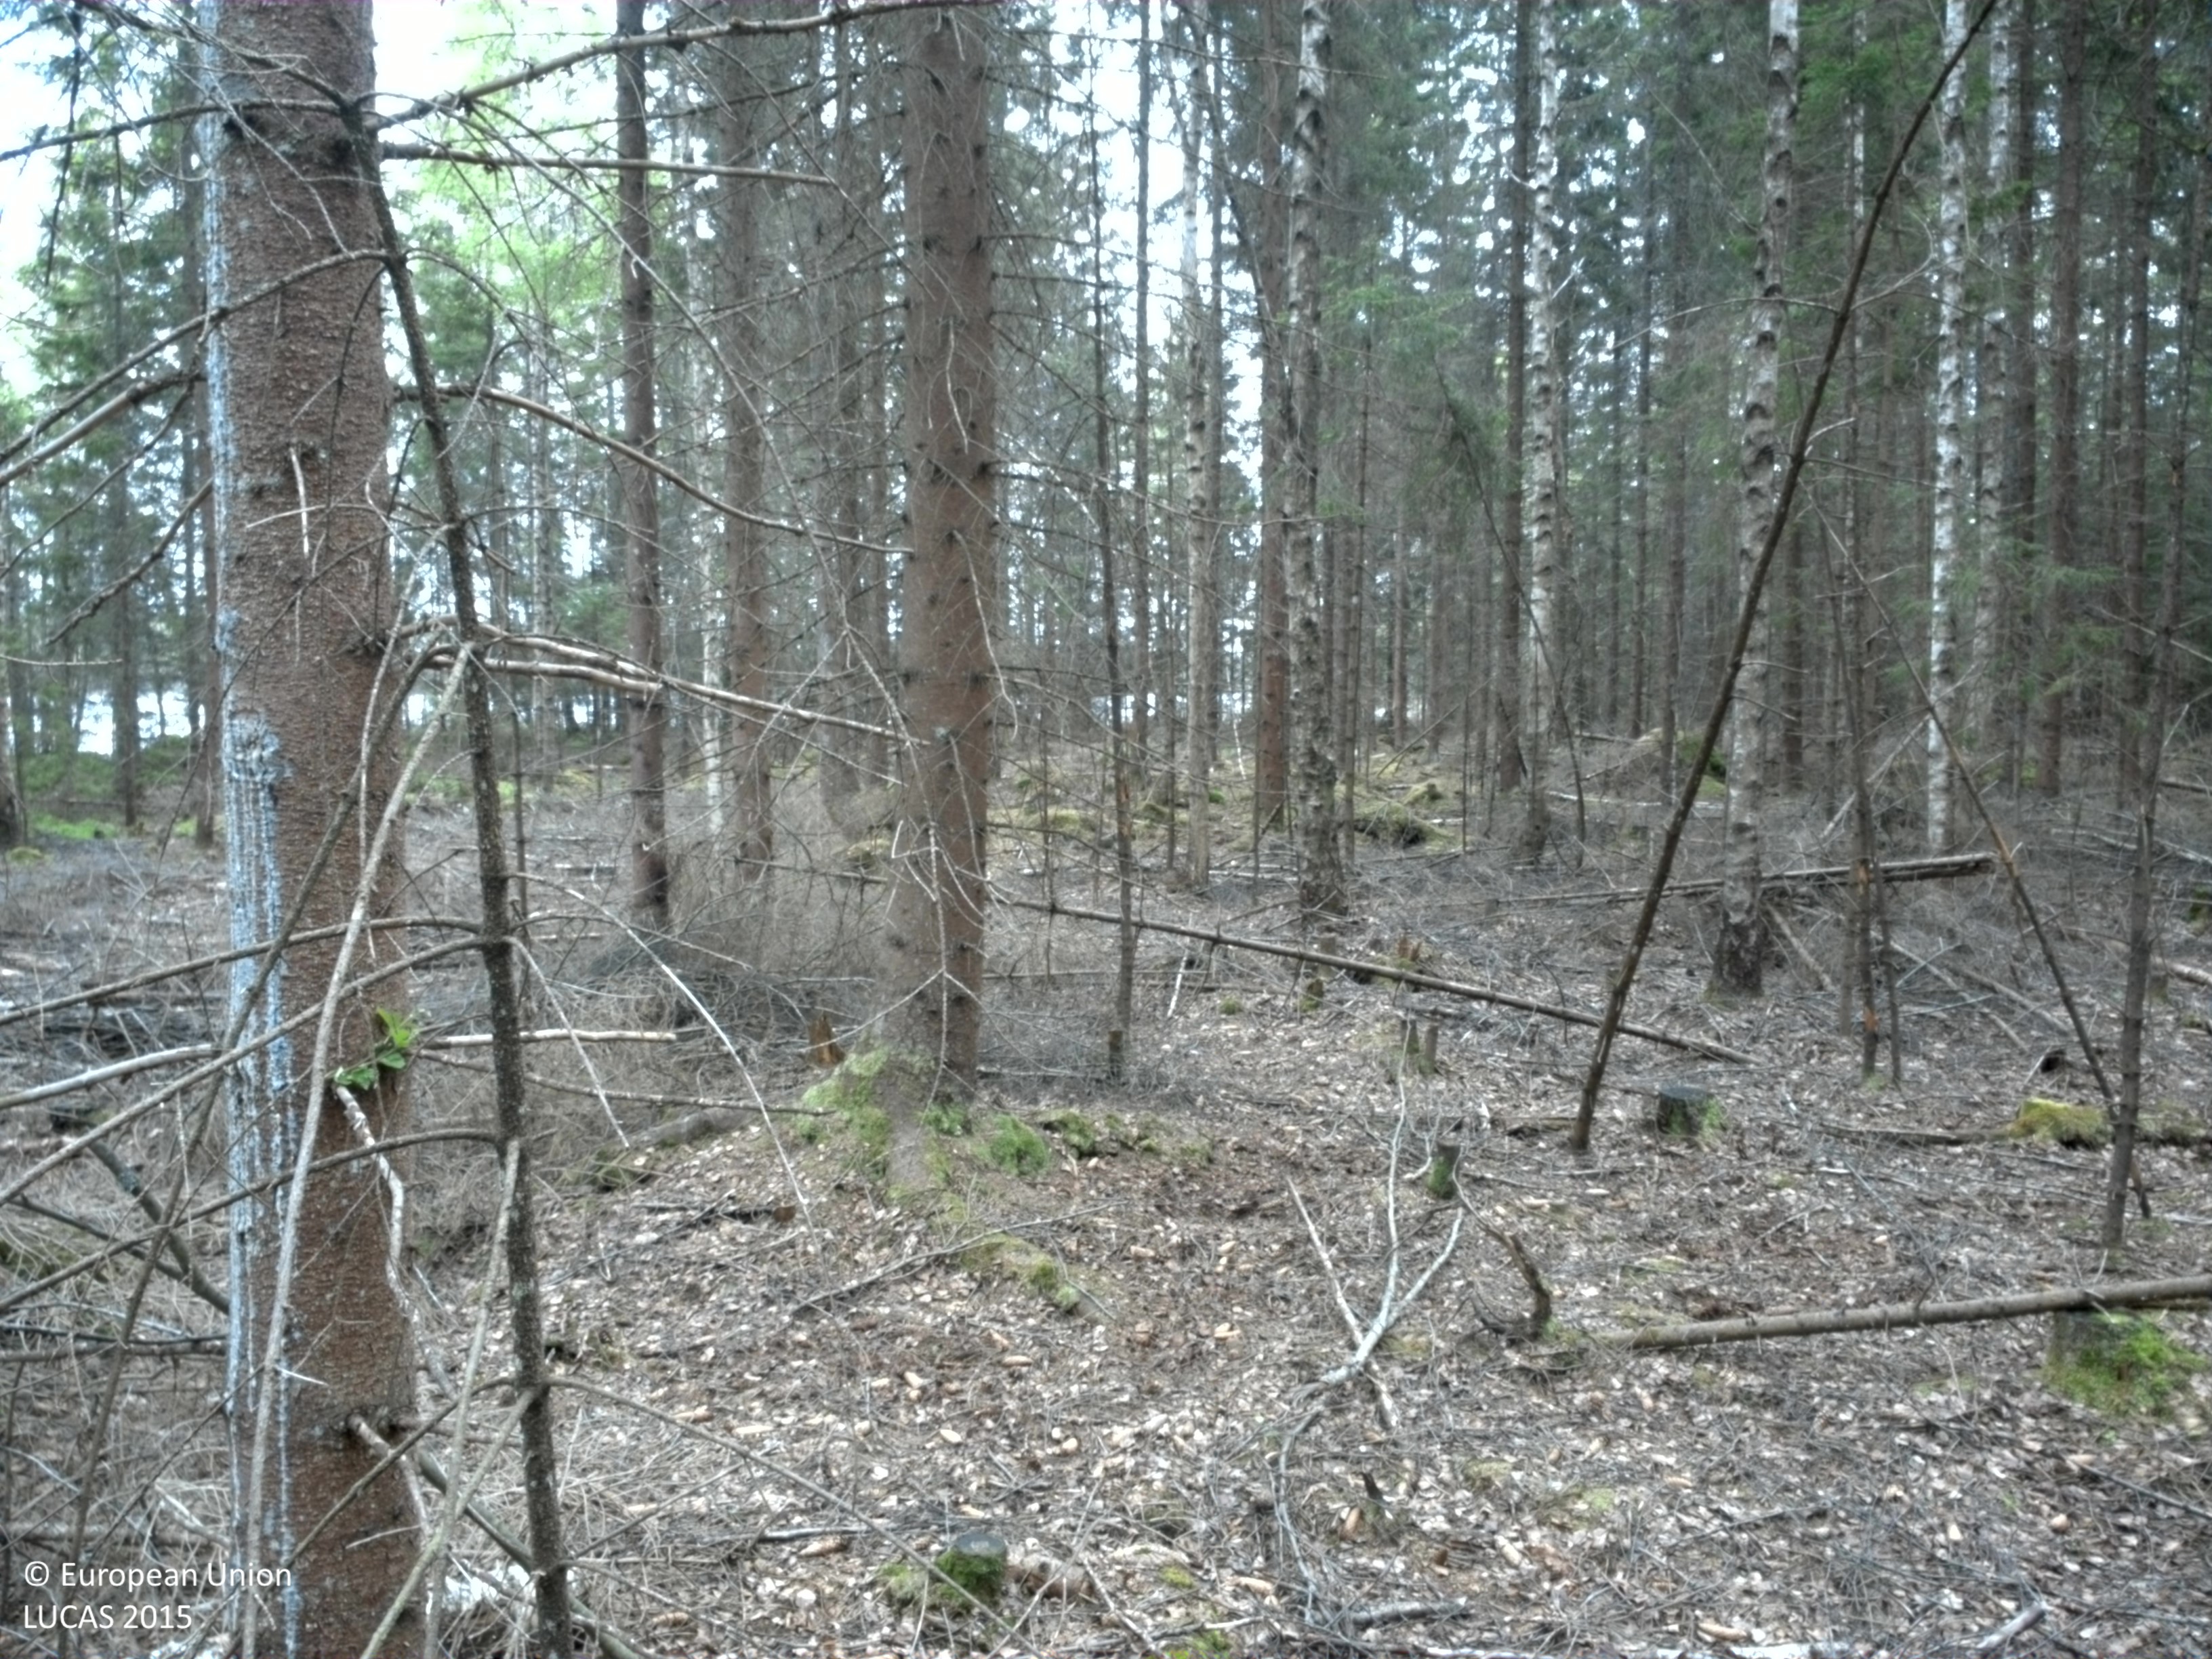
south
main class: Woodland
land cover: Spruce dominated mixed woodland
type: boreal forest
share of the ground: 50 - 75 %
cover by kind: coniferous forest trees 30 %, broadleaved forest trees 30 %, lichens and mosses 30 %, shrubs 10 %
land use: Forestry
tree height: > 5 m
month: May
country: SE
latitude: 56.8548
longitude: 15.2619
